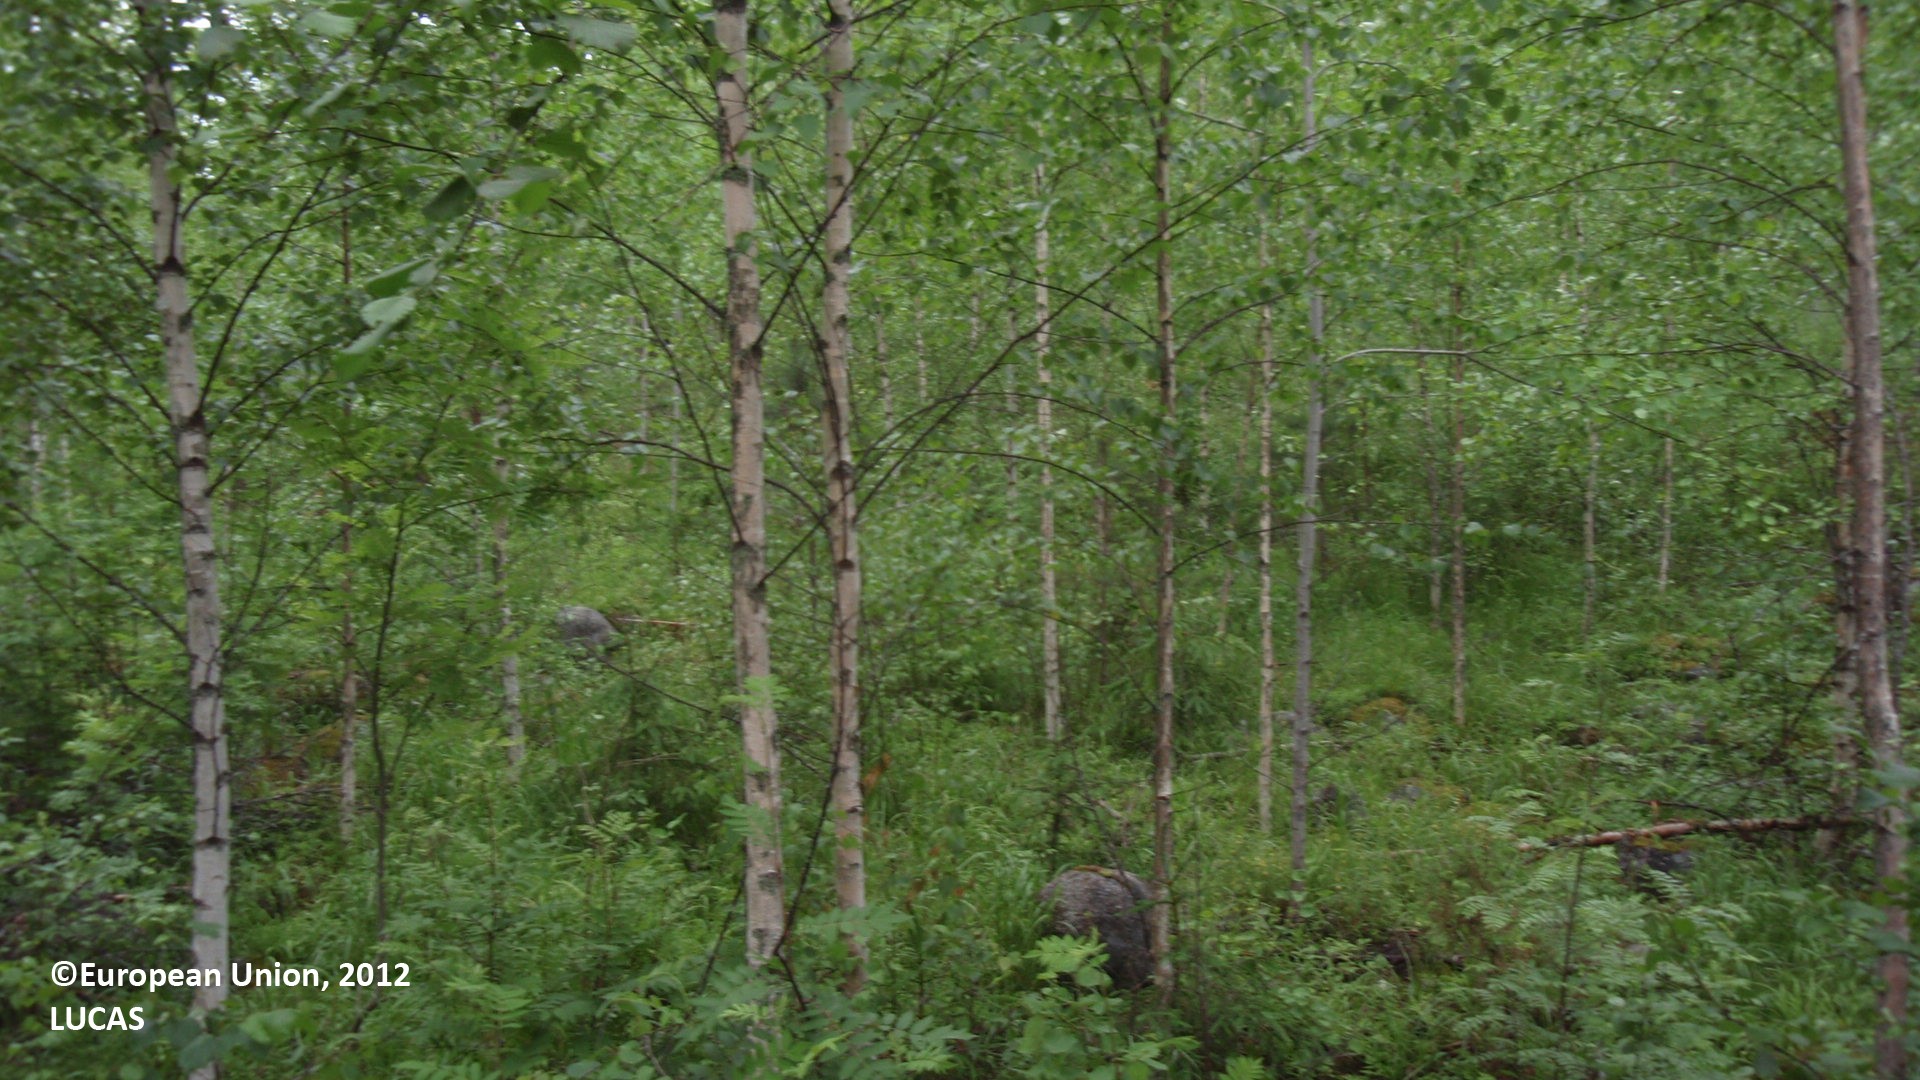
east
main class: Woodland
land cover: Broadleaved woodland
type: boreal forest
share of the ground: > 75 %
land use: Forestry
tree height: > 5 m
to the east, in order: Broadleaved woodland; Other mixed woodland; Inland water bodies
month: June
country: FI
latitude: 61.3366
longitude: 26.6941
